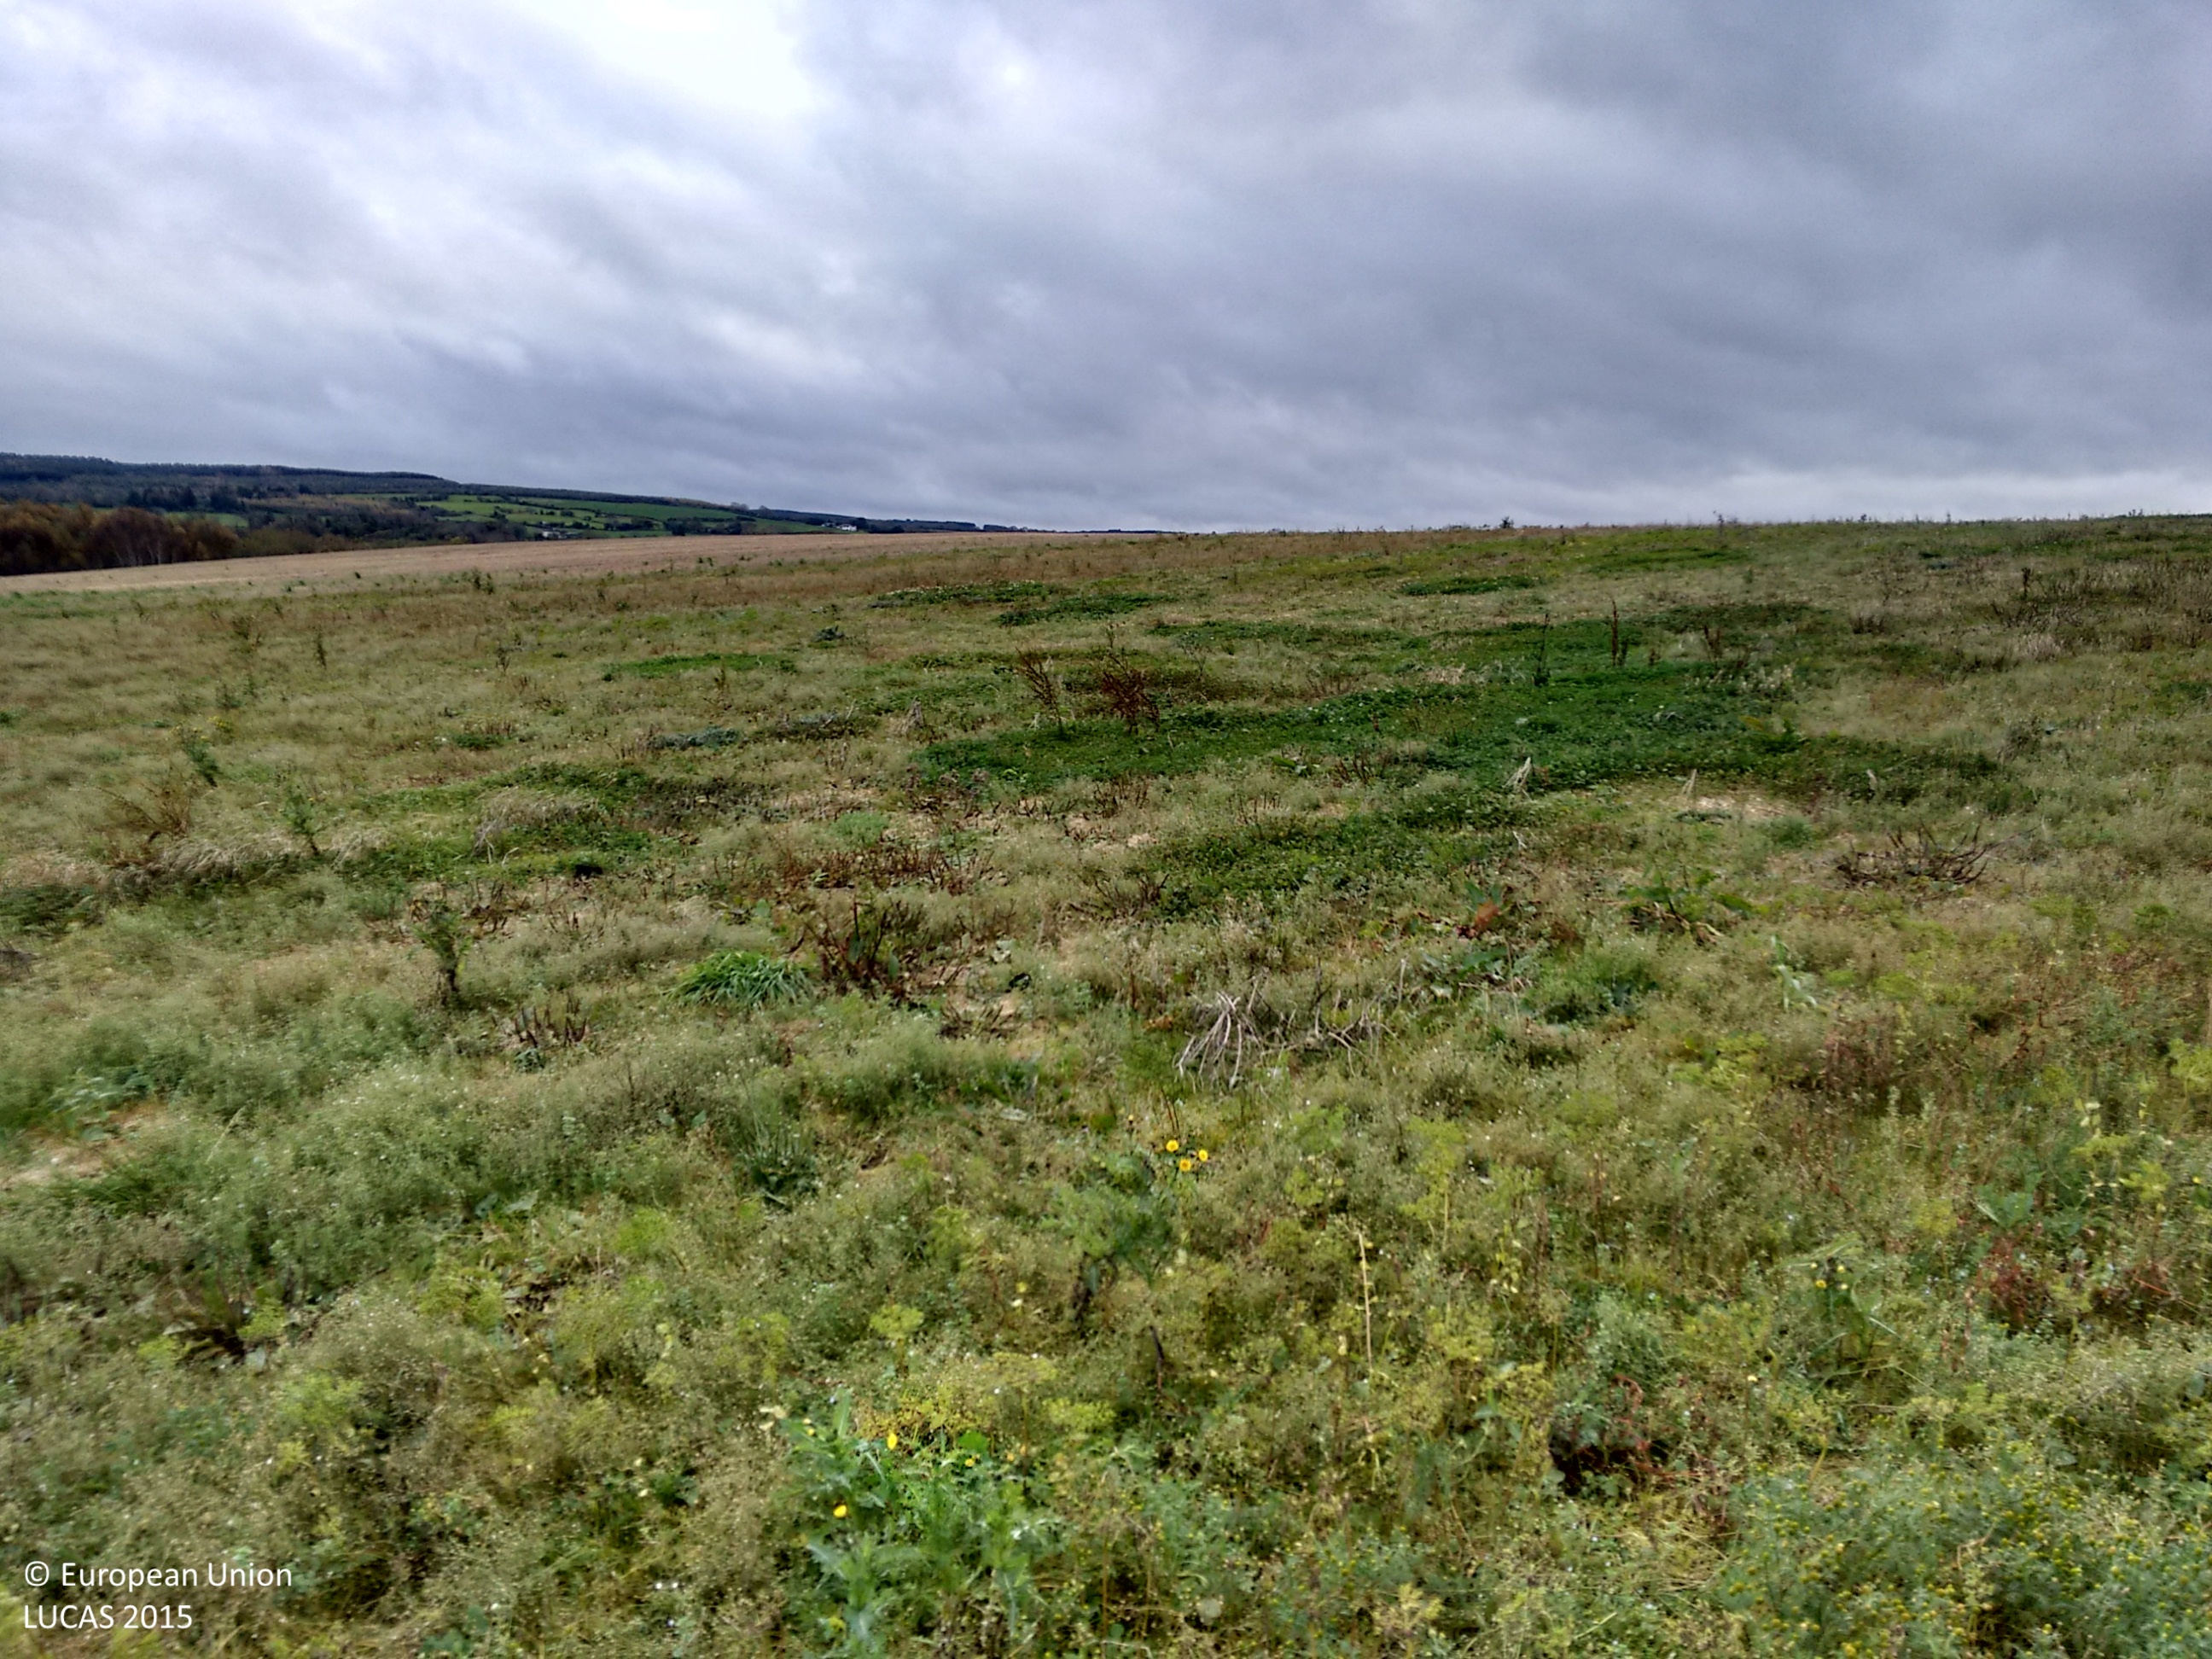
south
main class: Grassland
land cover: Grassland without tree/shrub cover
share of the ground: > 75 %
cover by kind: herbaceous plants 95 %, shrubs 5 %
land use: Agriculture (excluding fallow land and kitchen gardens)
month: November
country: IE
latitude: 53.1641
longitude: -7.6177
